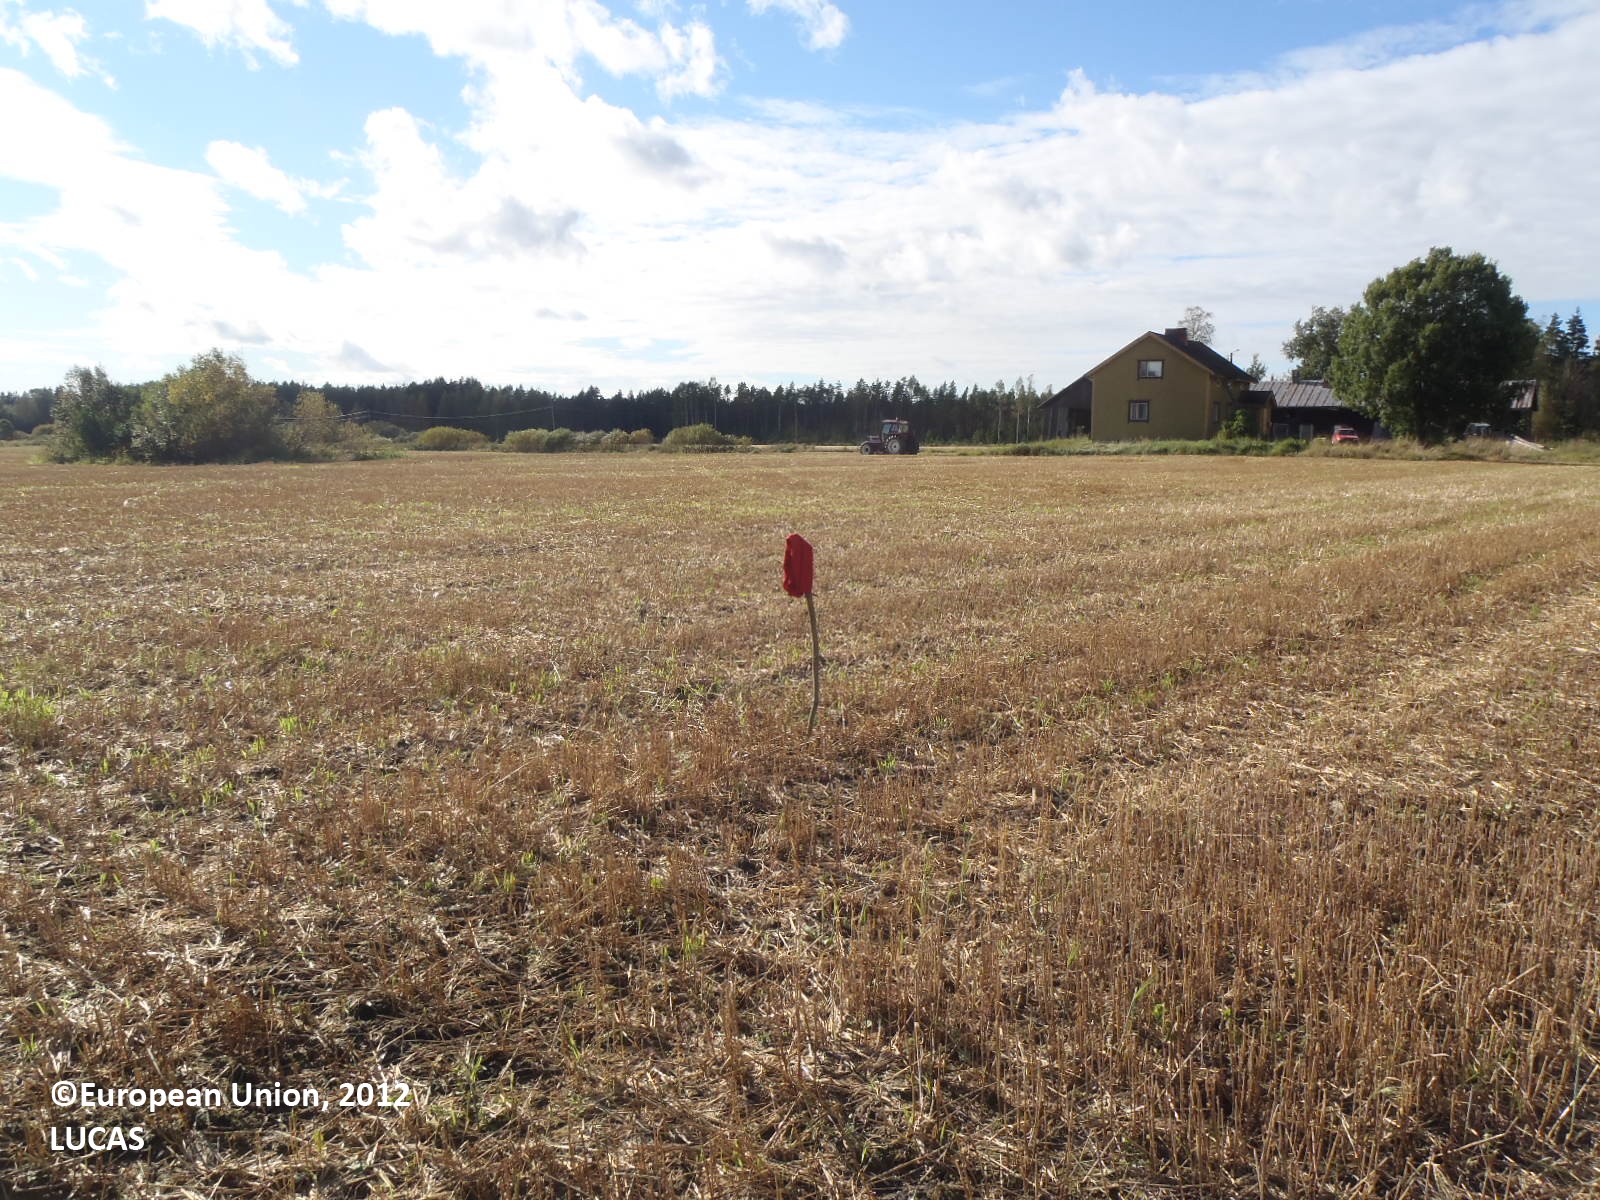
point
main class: Cropland
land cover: Barley
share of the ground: 50 - 75 %
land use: Agriculture (excluding fallow land and kitchen gardens)
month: September
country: FI
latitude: 61.2867
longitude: 22.4729
